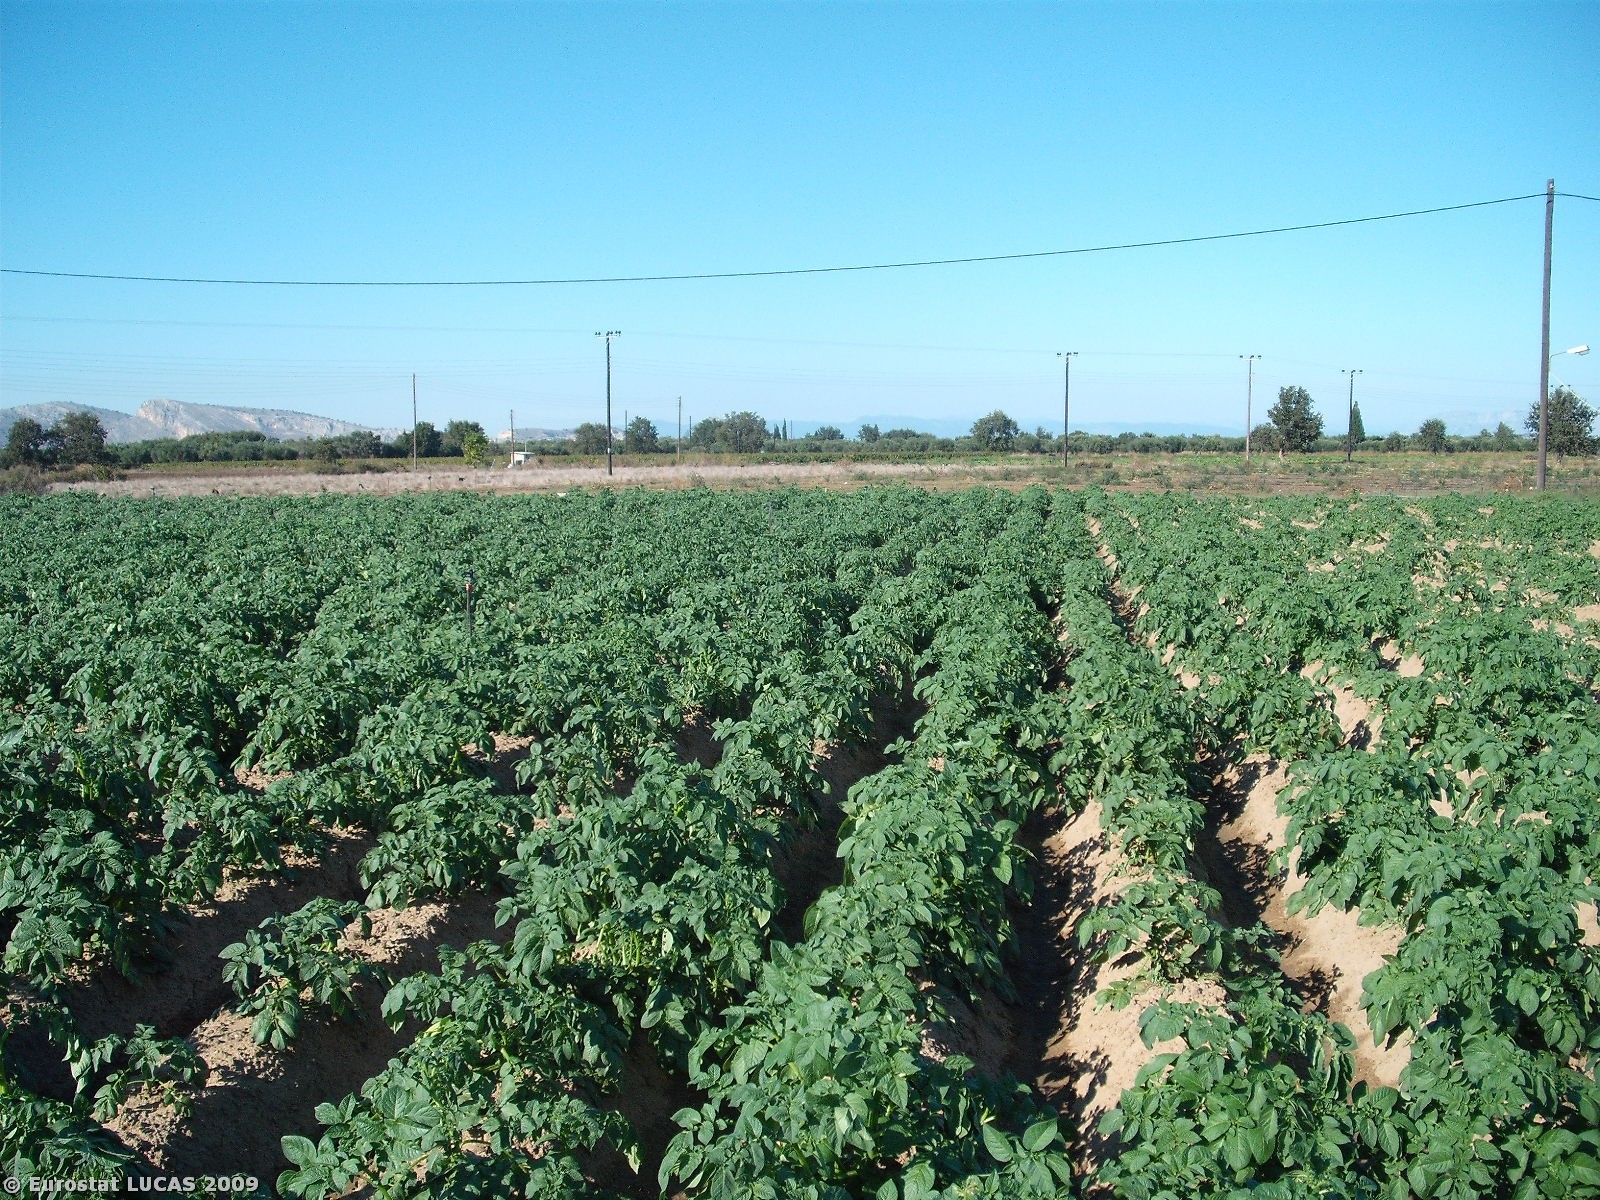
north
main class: Cropland
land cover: Potatoes
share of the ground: 50 - 75 %
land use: Agriculture (excluding fallow land and kitchen gardens)
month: October
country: GR
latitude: 38.1021
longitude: 21.4018
